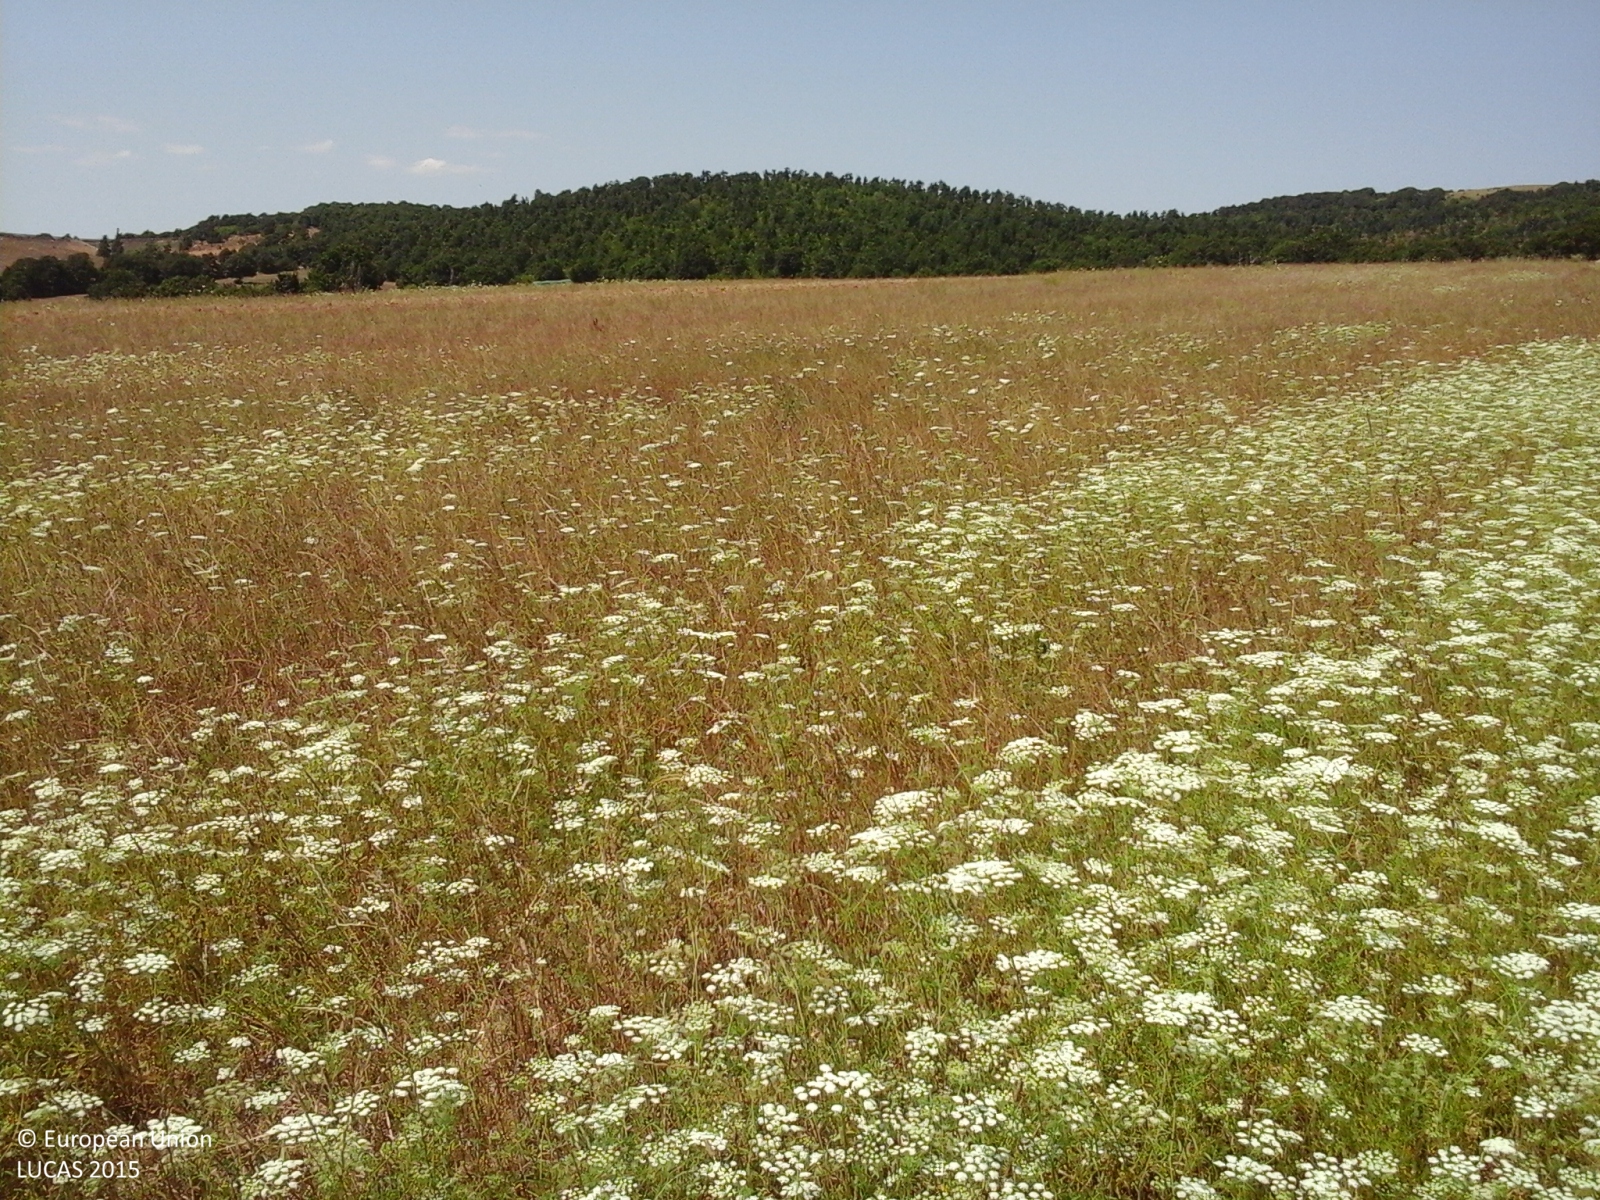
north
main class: Cropland
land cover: Temporary grasslands
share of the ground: > 75 %
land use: Agriculture (excluding fallow land and kitchen gardens)
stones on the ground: < 10 %
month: July
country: IT
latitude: 42.4805
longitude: 11.4911
